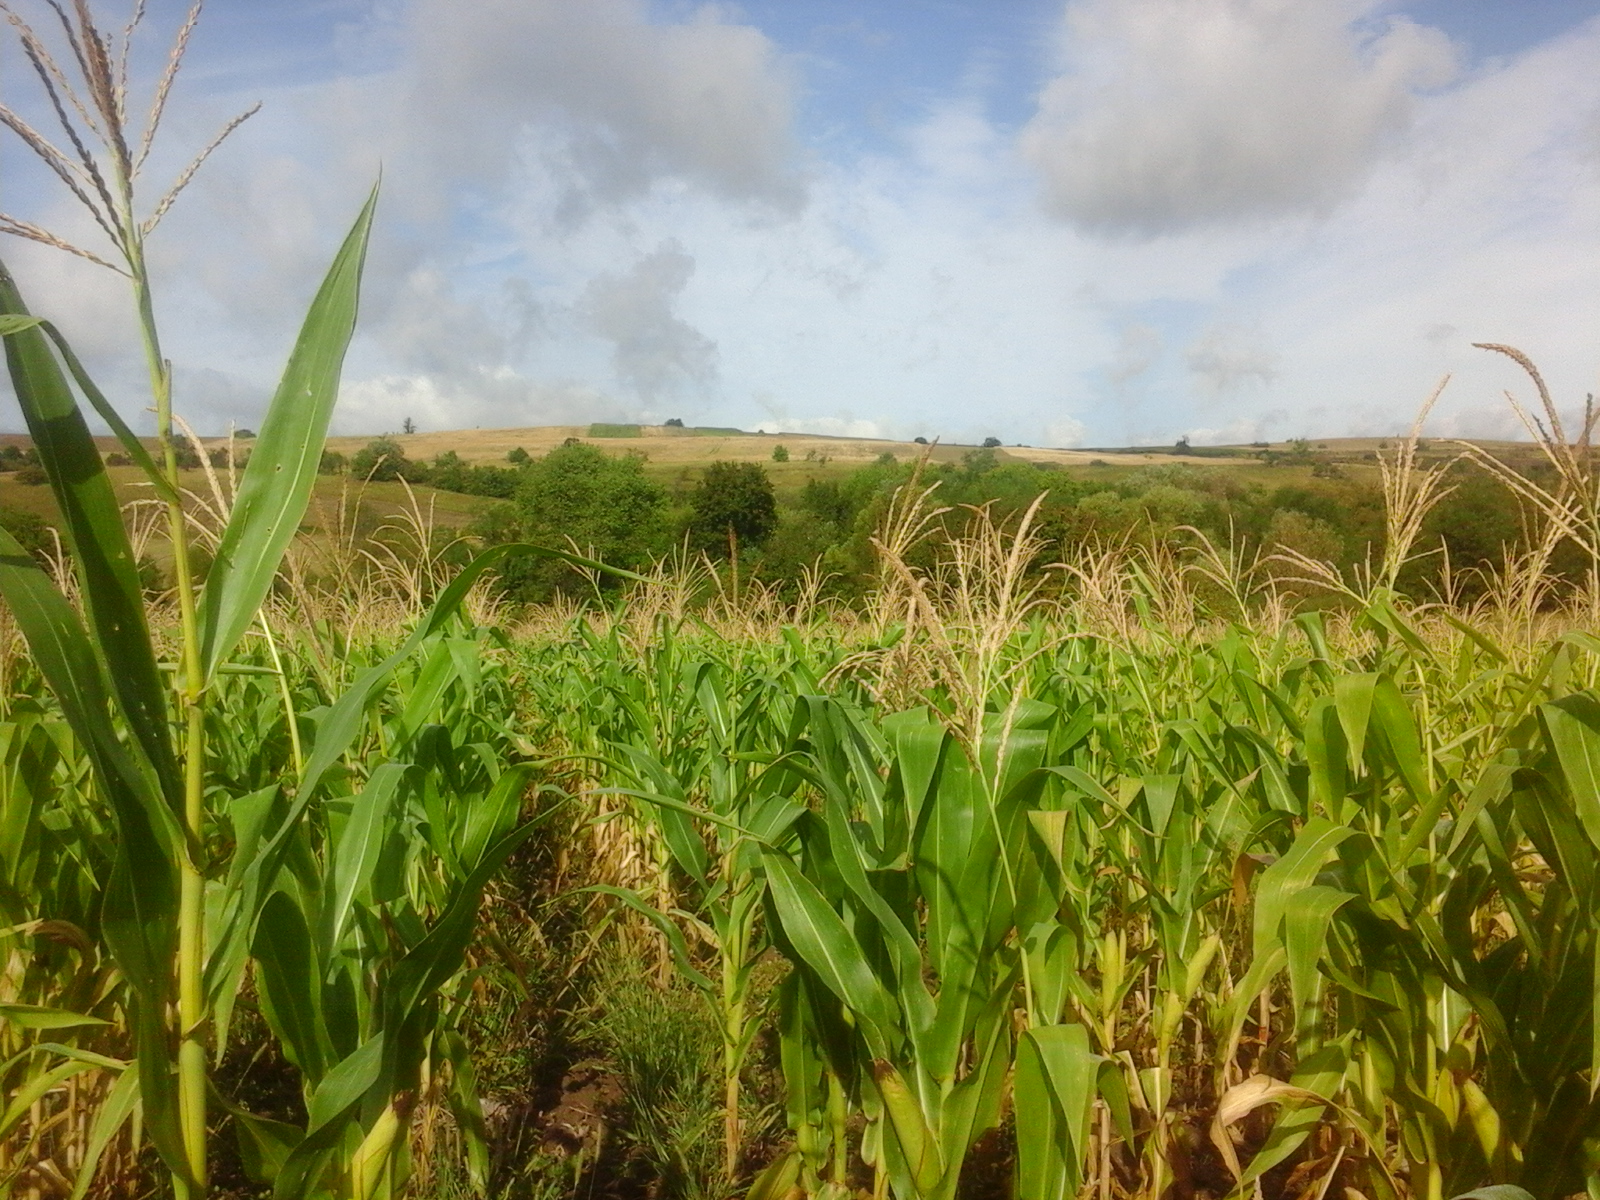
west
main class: Cropland
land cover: Maize
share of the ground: > 75 %
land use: Agriculture (excluding fallow land and kitchen gardens)
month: August
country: RO
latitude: 45.1872
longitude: 21.6265
